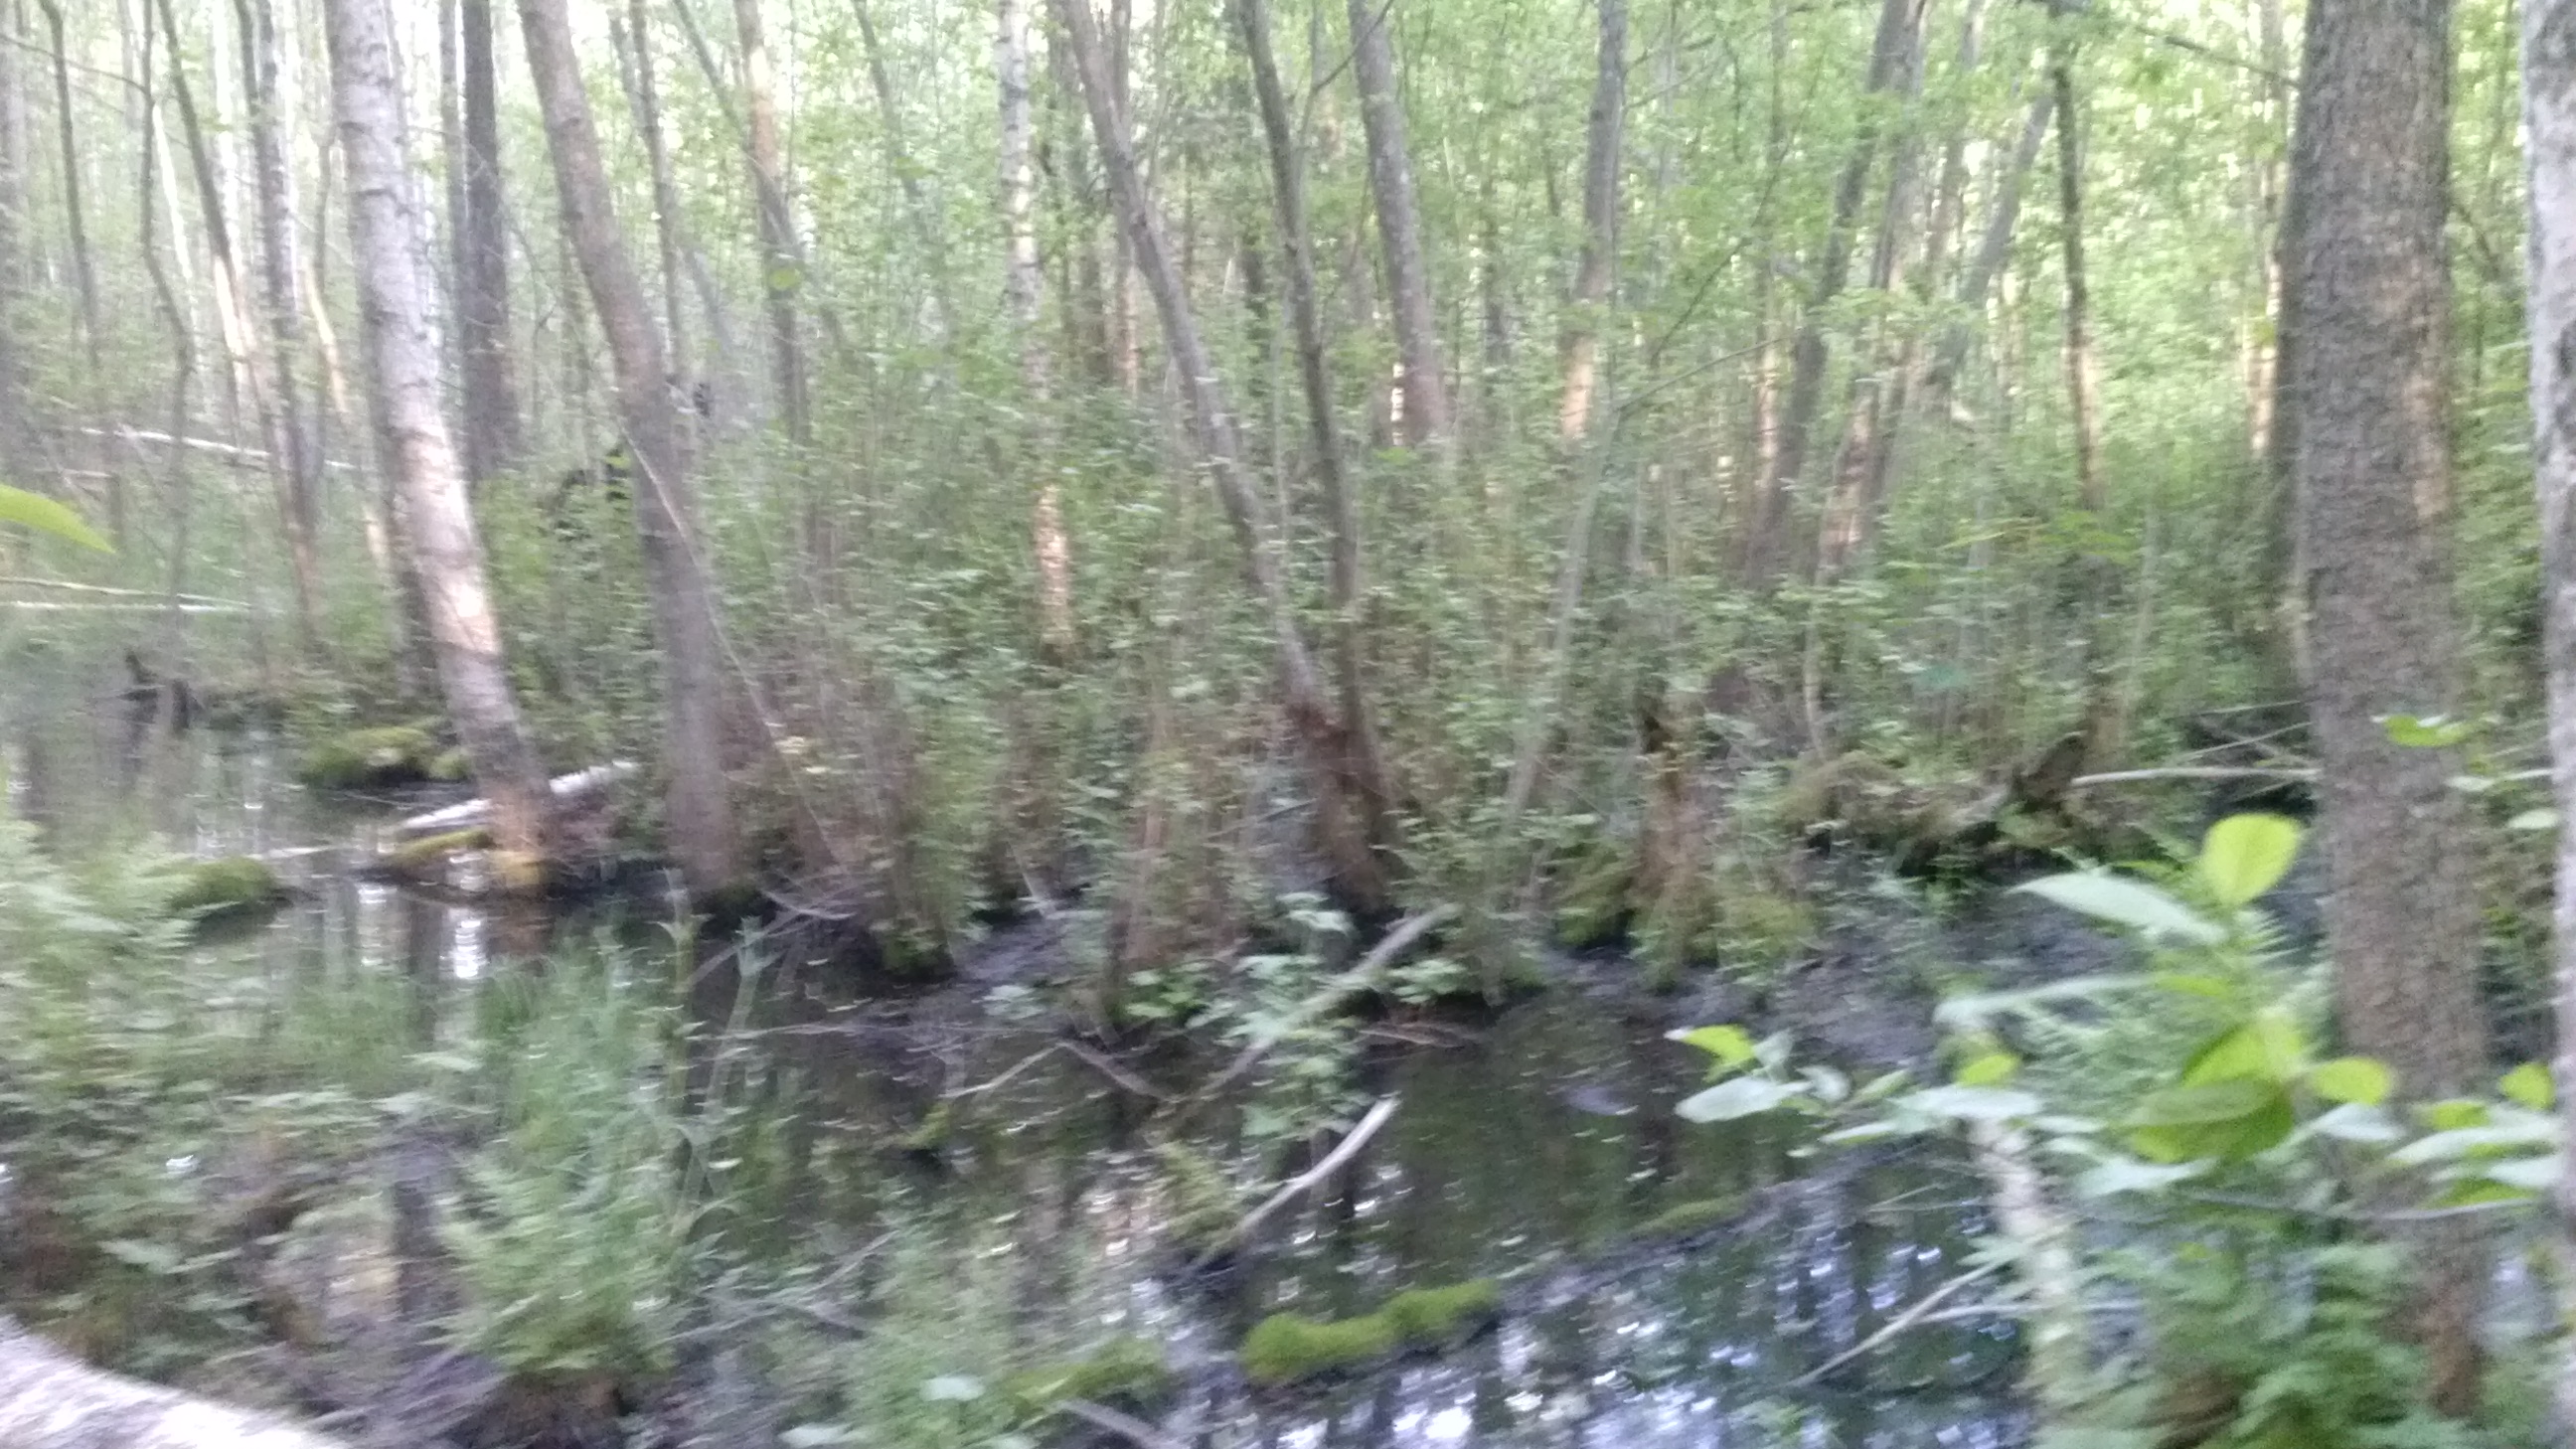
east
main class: Woodland
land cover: Broadleaved woodland
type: non-riverine alder, birch or aspen forest
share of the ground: > 75 %
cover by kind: broadleaved forest trees 100 %
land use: Forestry
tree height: > 5 m
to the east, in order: Broadleaved woodland; Spruce dominated mixed woodland
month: June
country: LV
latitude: 56.3133
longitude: 27.9289
